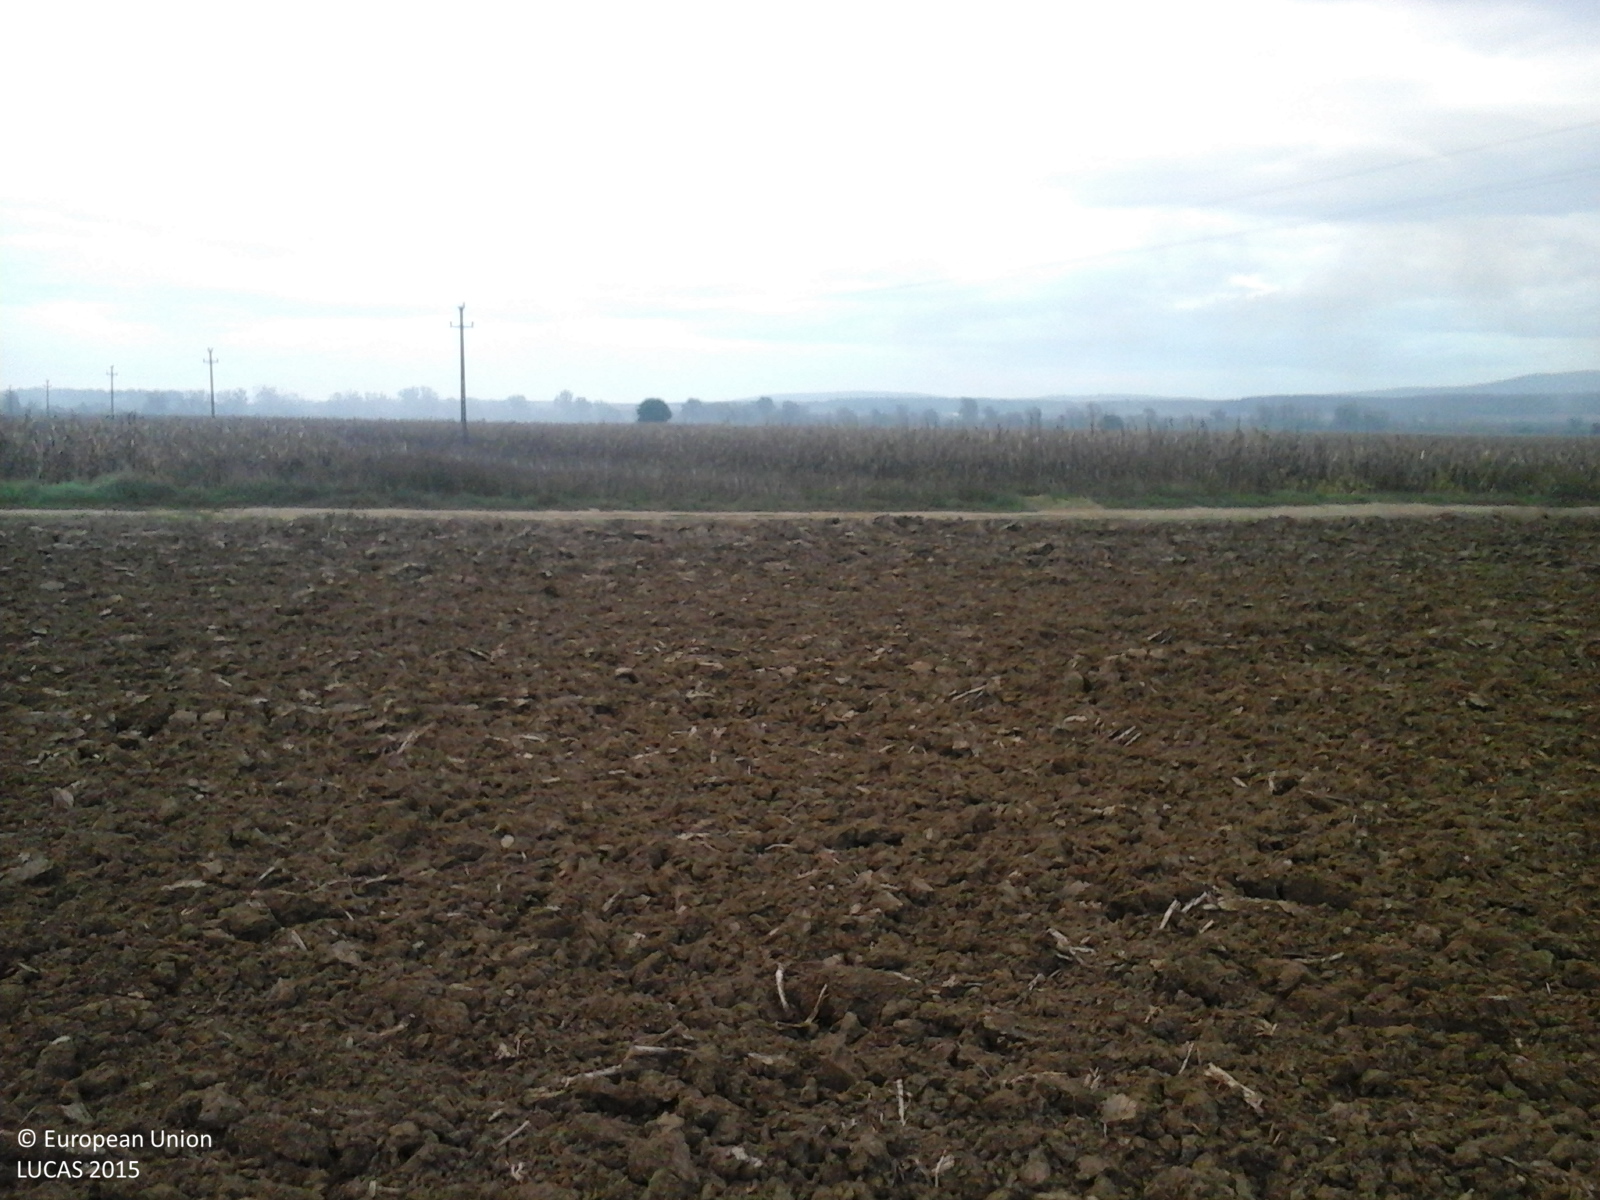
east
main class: Cropland
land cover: Maize
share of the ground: < 10 %
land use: Agriculture (excluding fallow land and kitchen gardens)
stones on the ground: < 10 %
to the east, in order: Maize; Grass margins; Tracks; Shruby margins; Sunflower; Electric lines; Maize; Sunflower; Maize; Shruby margins; Maize; Other bare soil
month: October
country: RO
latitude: 45.9608
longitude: 23.3915
